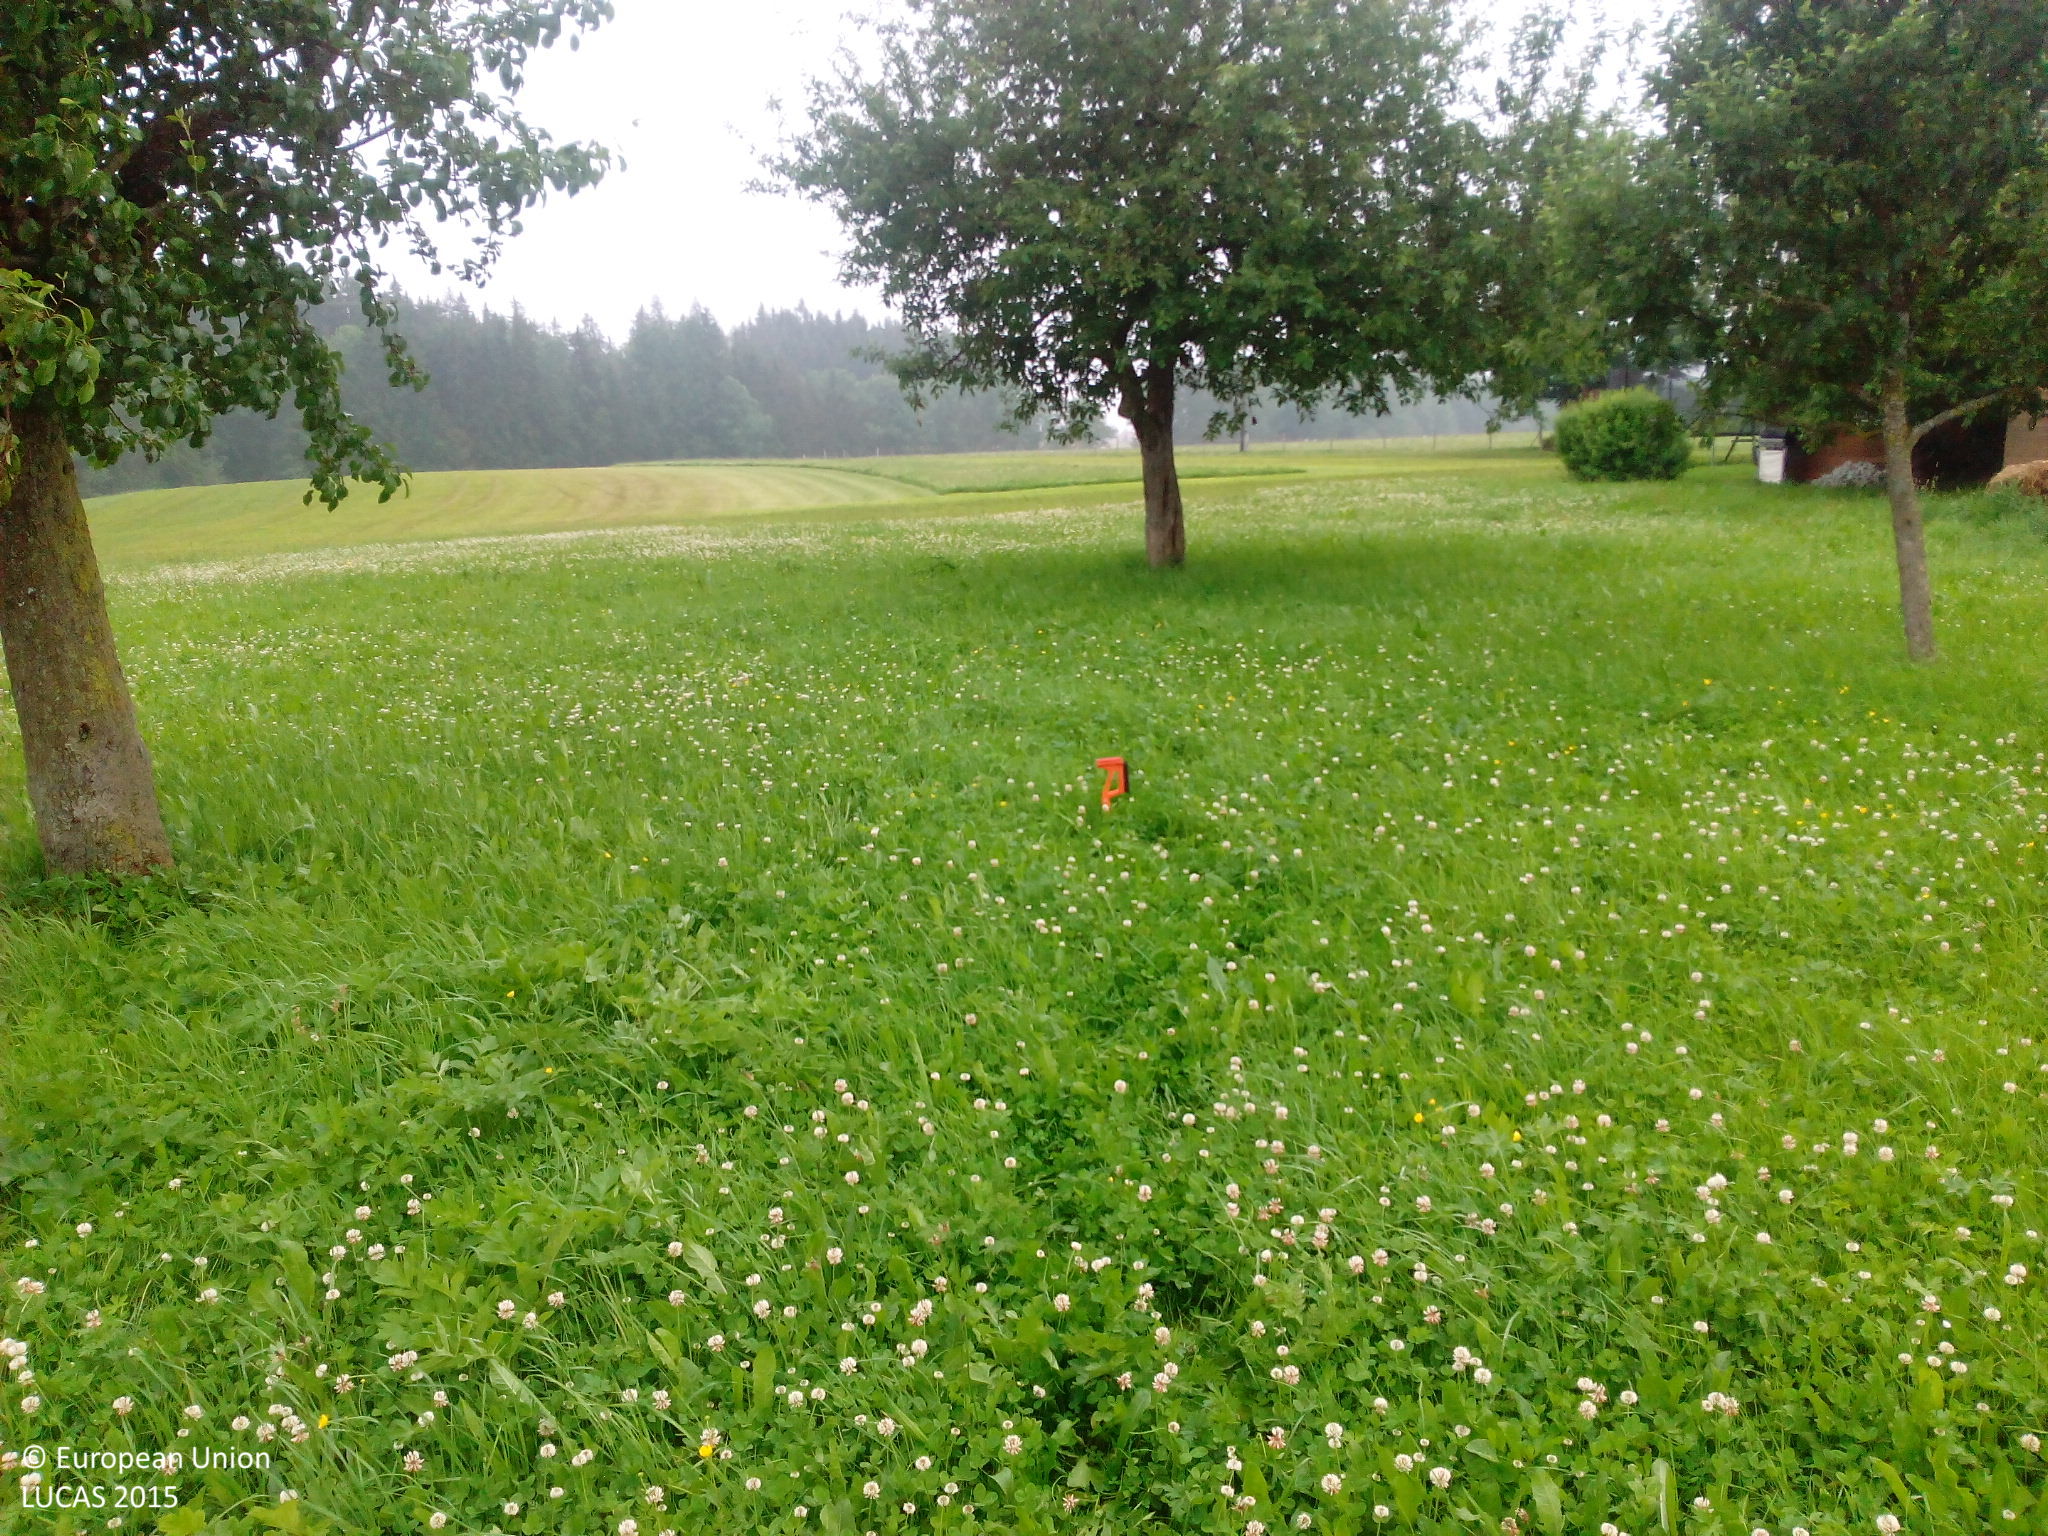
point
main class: Grassland
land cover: Grassland with sparse tree/shrub cover
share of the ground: > 75 %
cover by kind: herbaceous plants 95 %, broadleaved forest trees 5 %
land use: Agriculture (excluding fallow land and kitchen gardens)
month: June
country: DE
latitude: 47.7373
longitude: 10.2532
